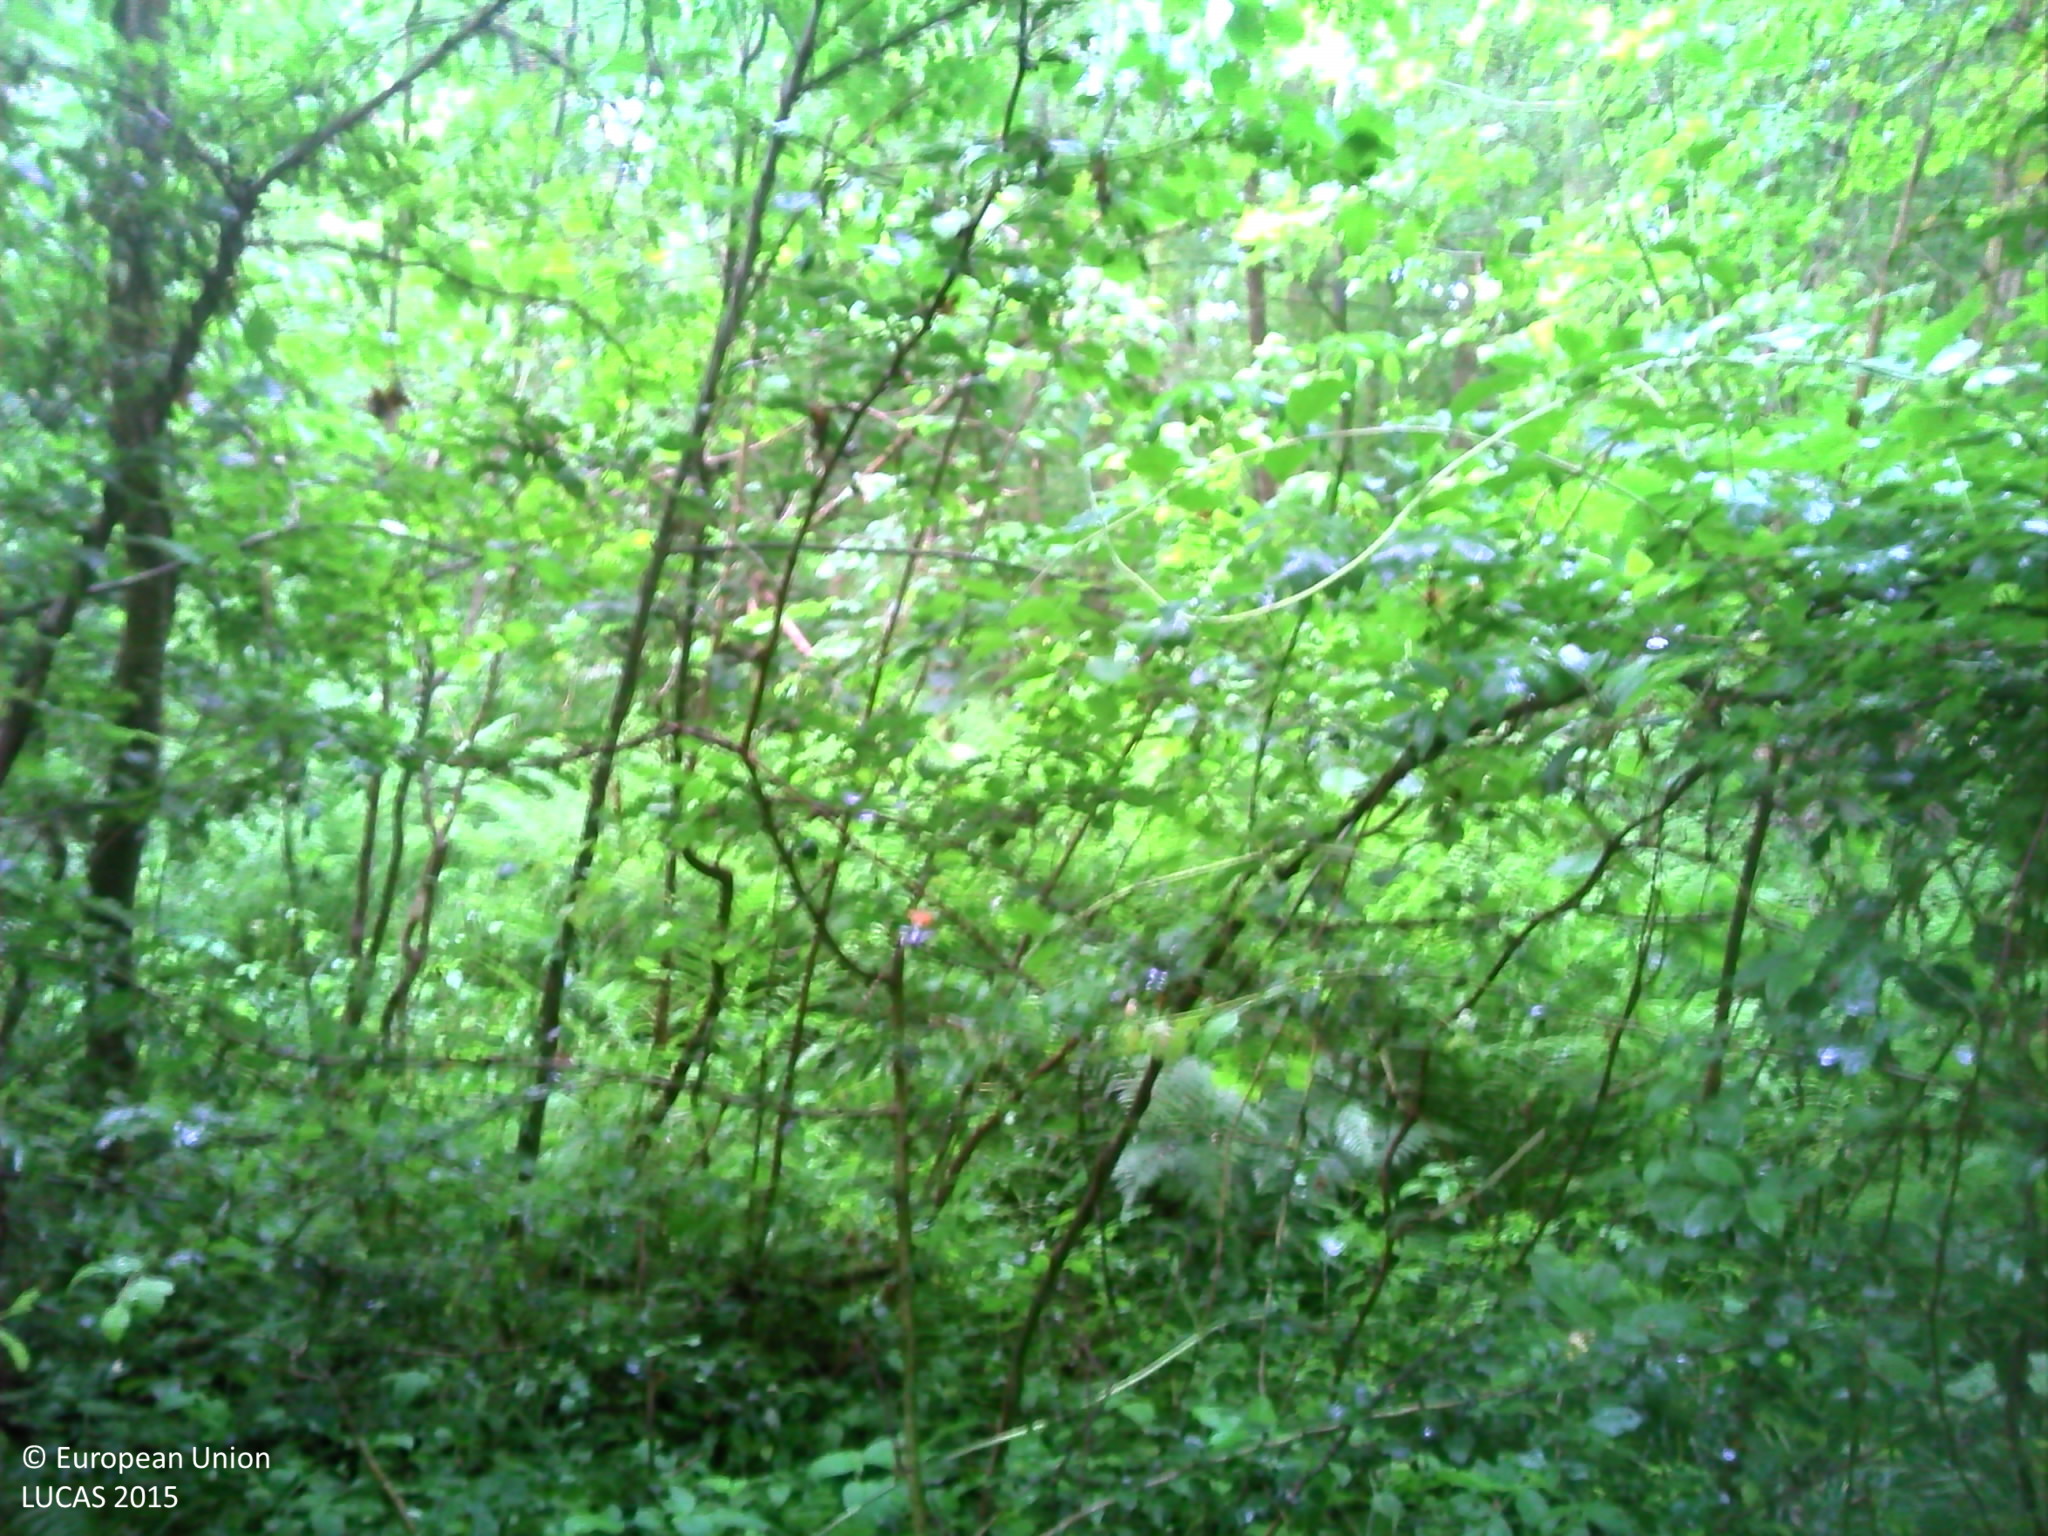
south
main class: Woodland
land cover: Broadleaved woodland
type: mesophytic deciduous forest
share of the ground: > 75 %
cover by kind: broadleaved forest trees 95 %, herbaceous plants 5 %
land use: Forestry
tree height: > 5 m
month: June
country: FR
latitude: 48.3579
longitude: 7.5312
